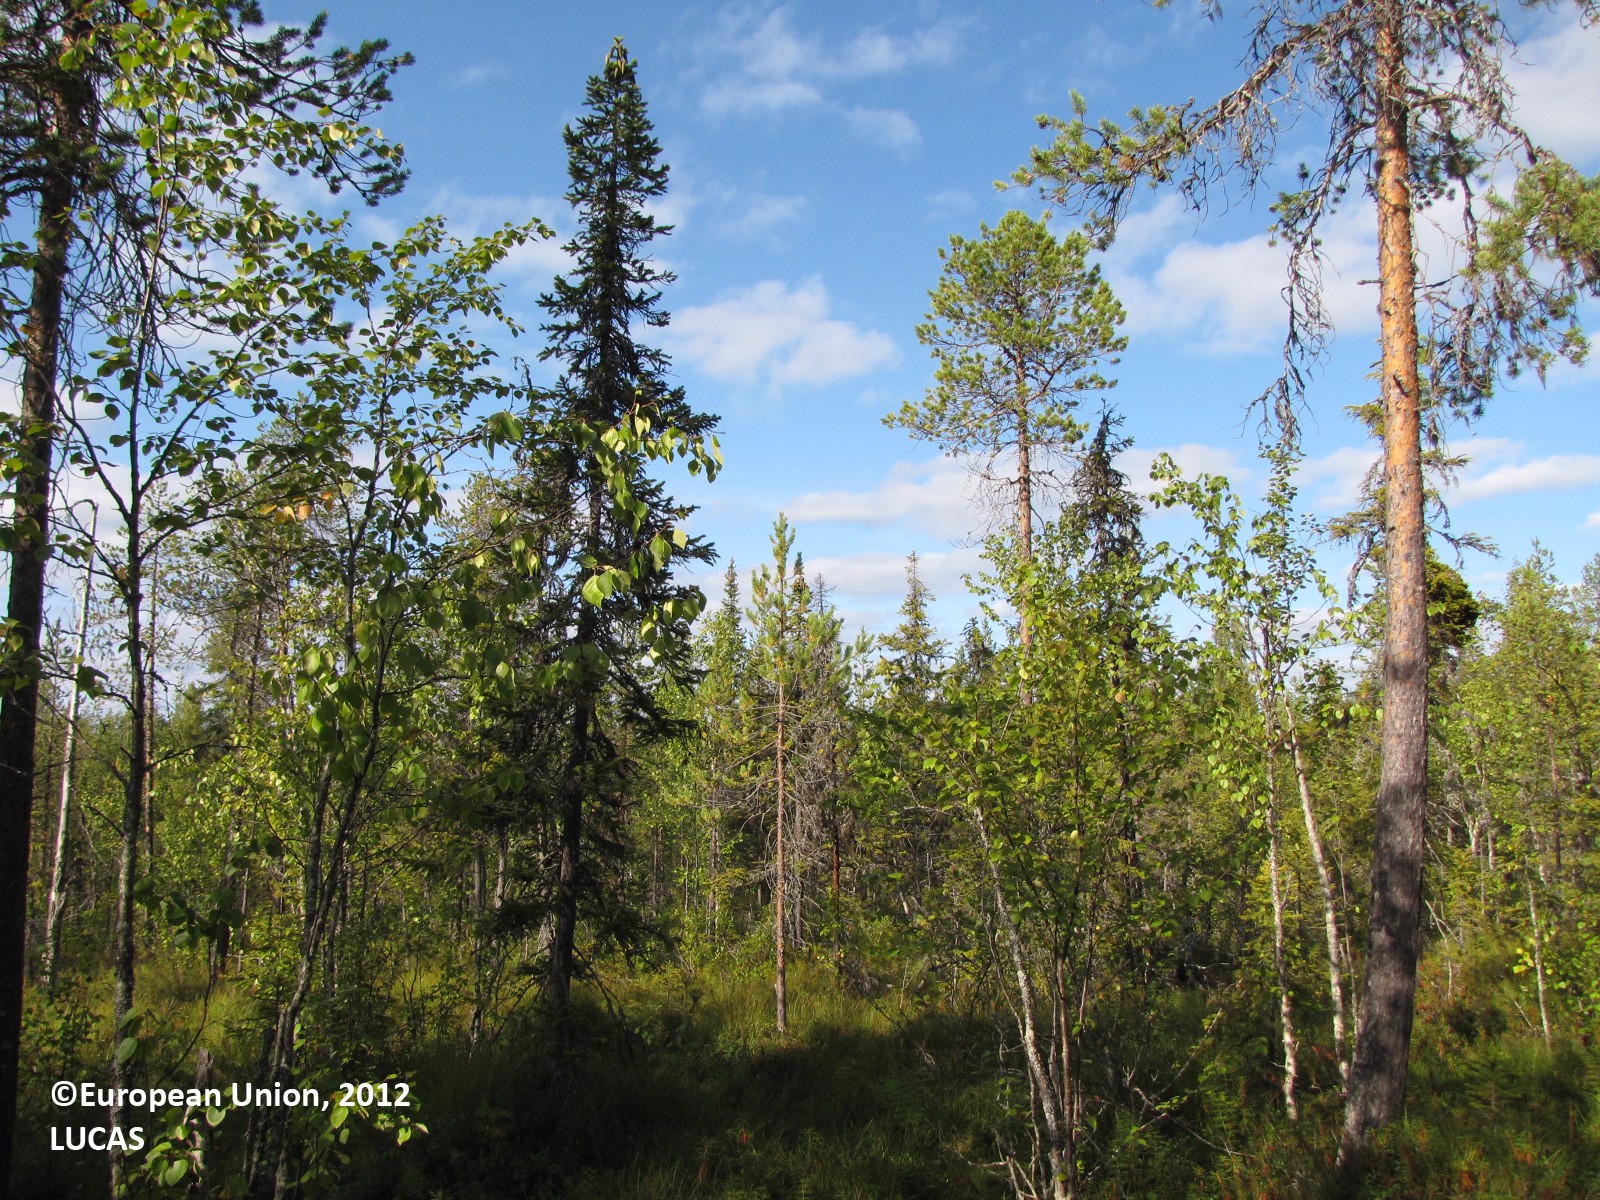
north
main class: Woodland
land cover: Pine dominated mixed woodland
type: boreal forest
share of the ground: 25 - 50 %
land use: Forestry
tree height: > 5 m
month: August
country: FI
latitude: 66.9681
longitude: 25.2375
